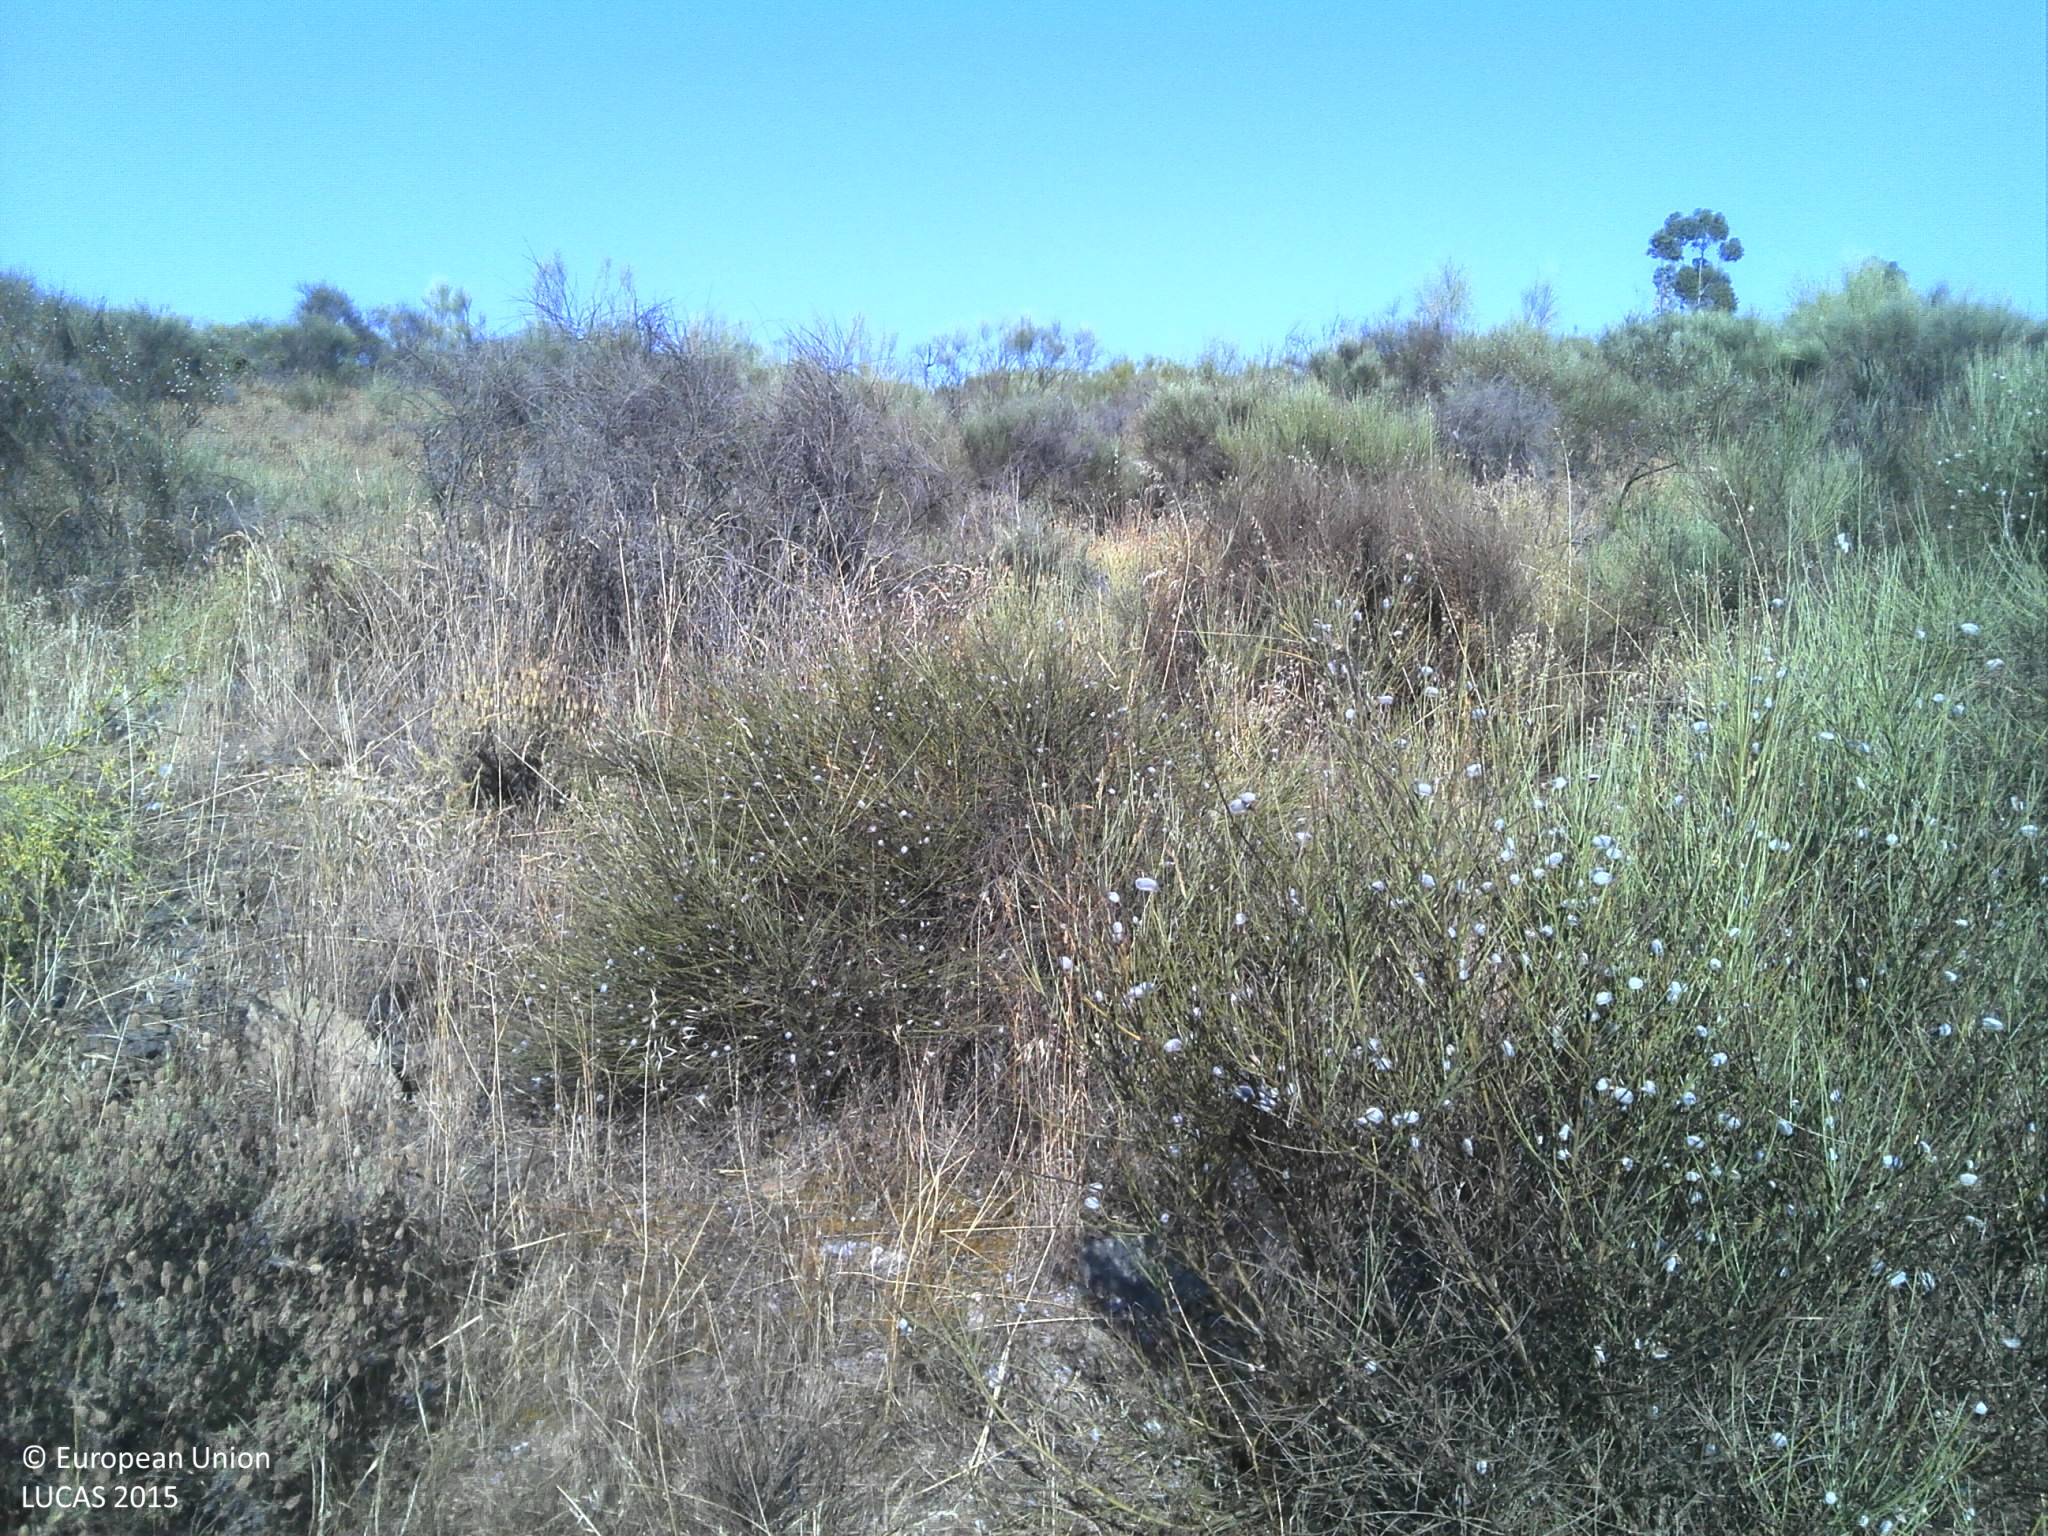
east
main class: Shrubland
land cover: Shrubland without tree cover
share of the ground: 50 - 75 %
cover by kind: shrubs 70 %, herbaceous plants 15 %, unconsolidated bare surface 10 %
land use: Abandoned areas
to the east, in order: Shrubland without tree cover; Tracks; Shrubland with sparse tree cover
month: June
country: PT
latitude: 39.8021
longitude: -7.0111
